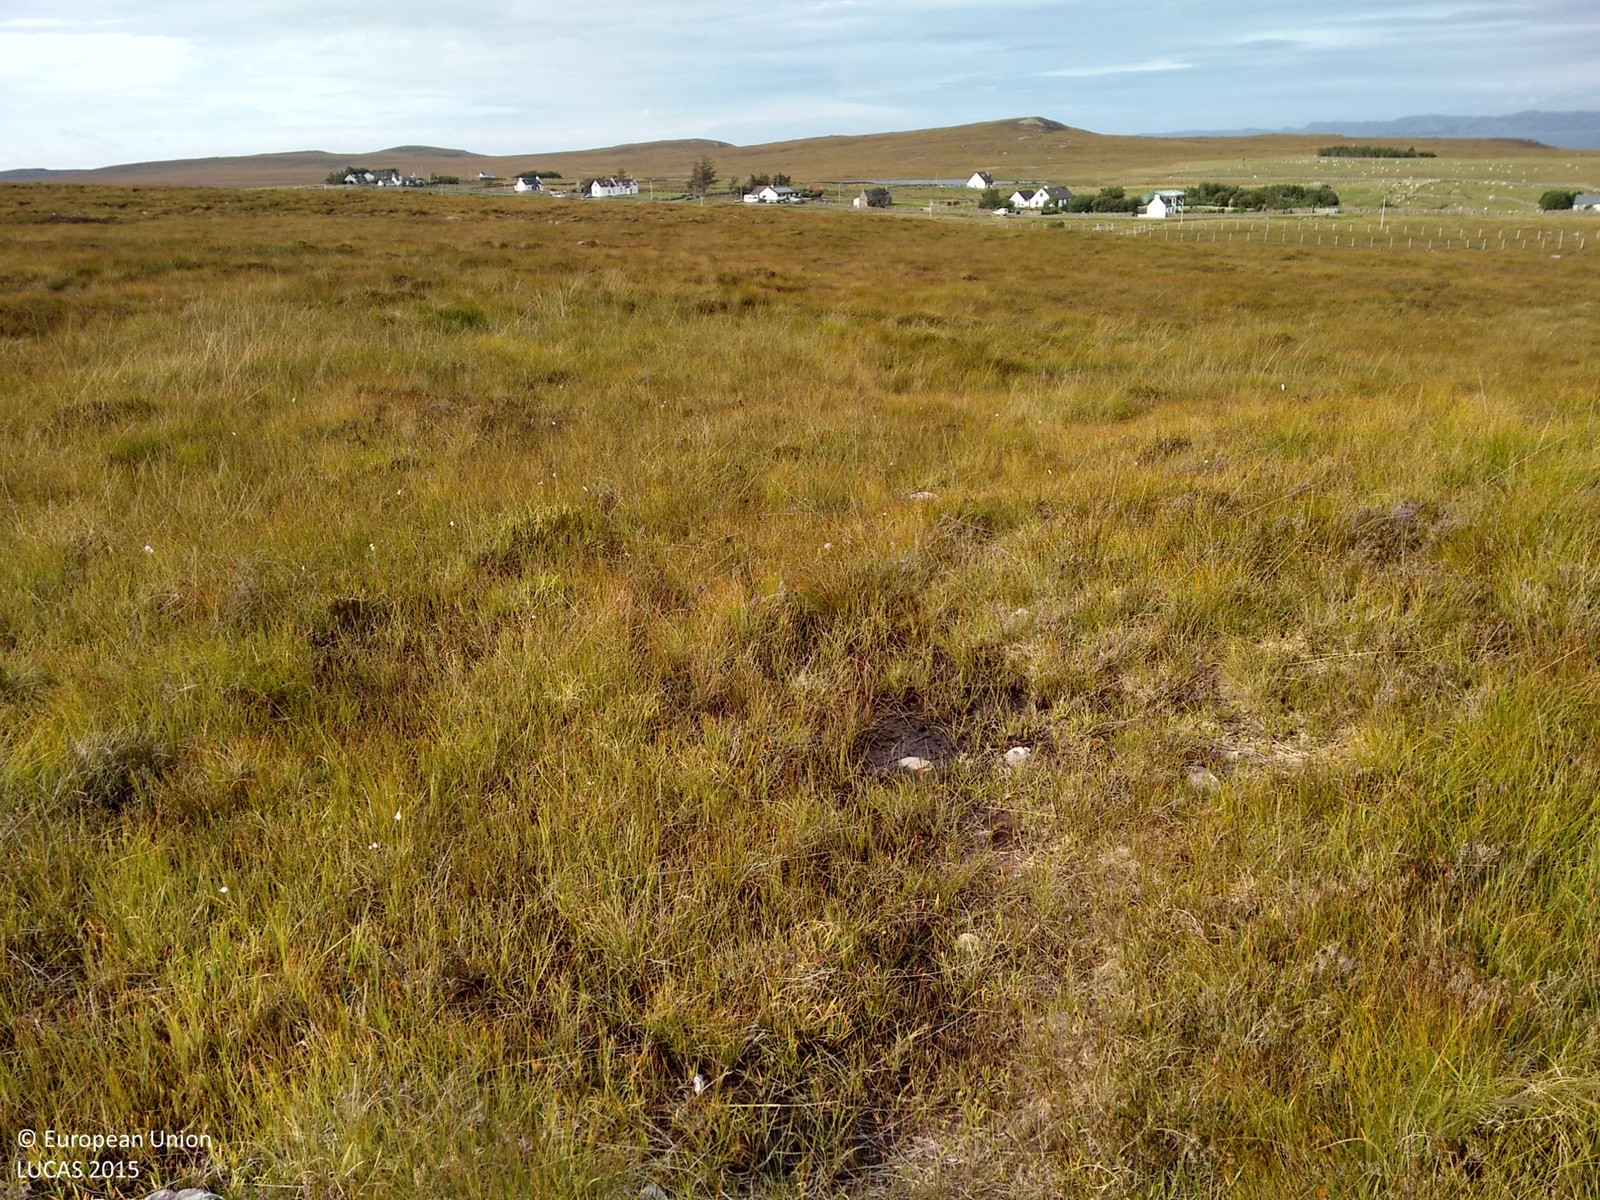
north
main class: Shrubland
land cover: Shrubland without tree cover
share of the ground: > 75 %
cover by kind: shrubs 75 %, herbaceous plants 25 %
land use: Agriculture (excluding fallow land and kitchen gardens)
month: September
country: GB
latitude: 58.0611
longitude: -5.3789
